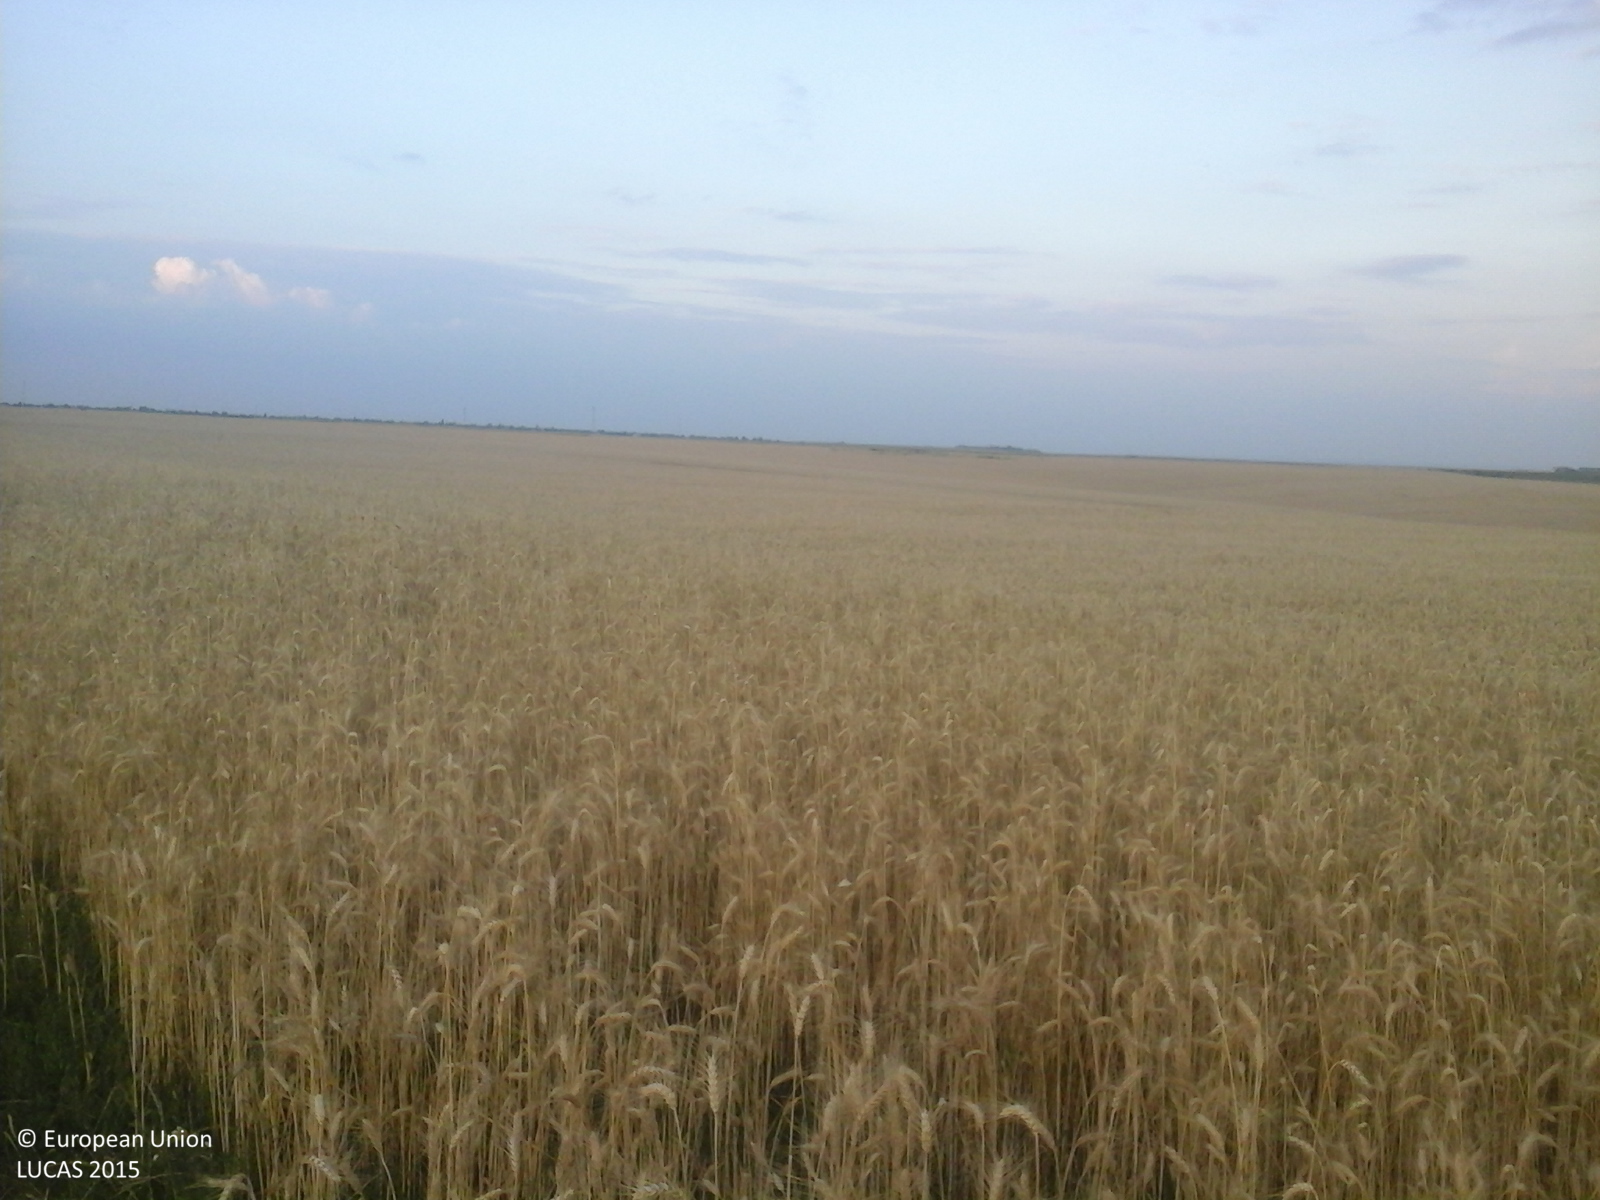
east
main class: Cropland
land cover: Common wheat
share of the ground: > 75 %
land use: Agriculture (excluding fallow land and kitchen gardens)
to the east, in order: Common wheat; Tracks; Common wheat
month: July
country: RO
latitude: 44.0069
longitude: 25.9493
